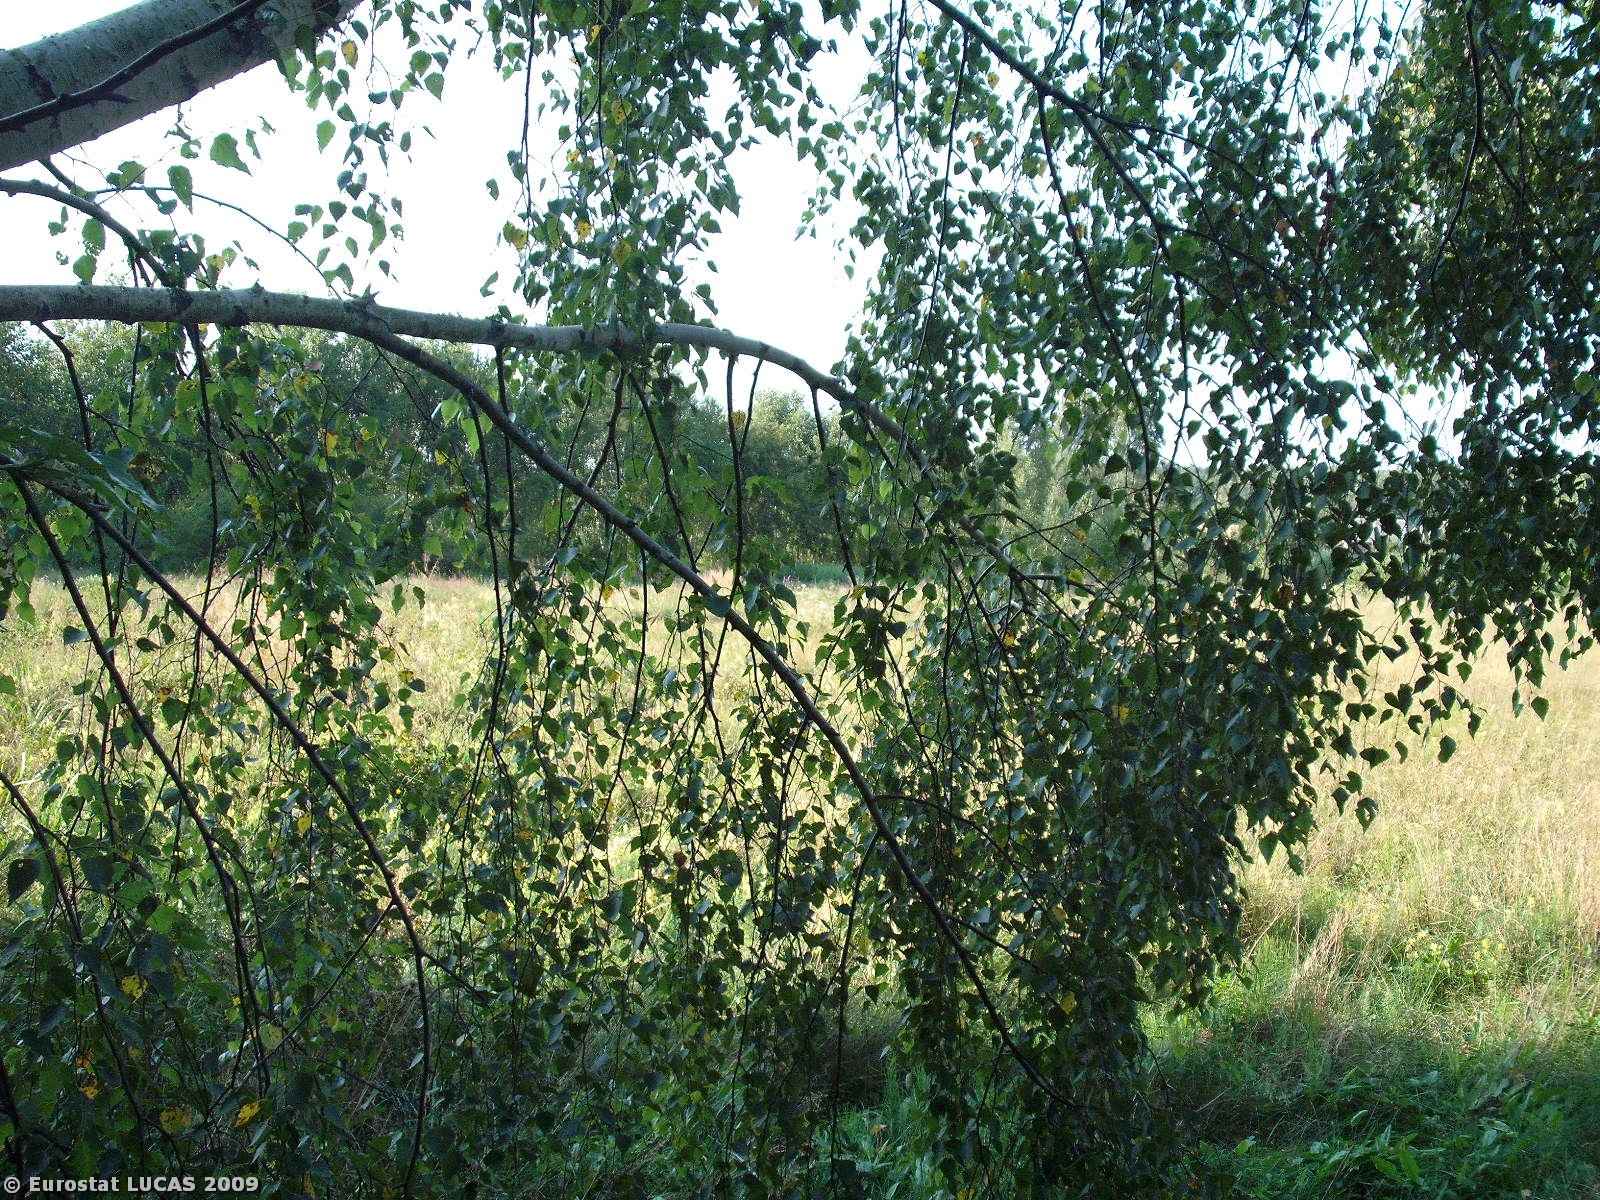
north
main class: Woodland
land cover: Broadleaved woodland
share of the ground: > 75 %
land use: Unused
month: August
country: PL
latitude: 50.5293
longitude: 21.2912
